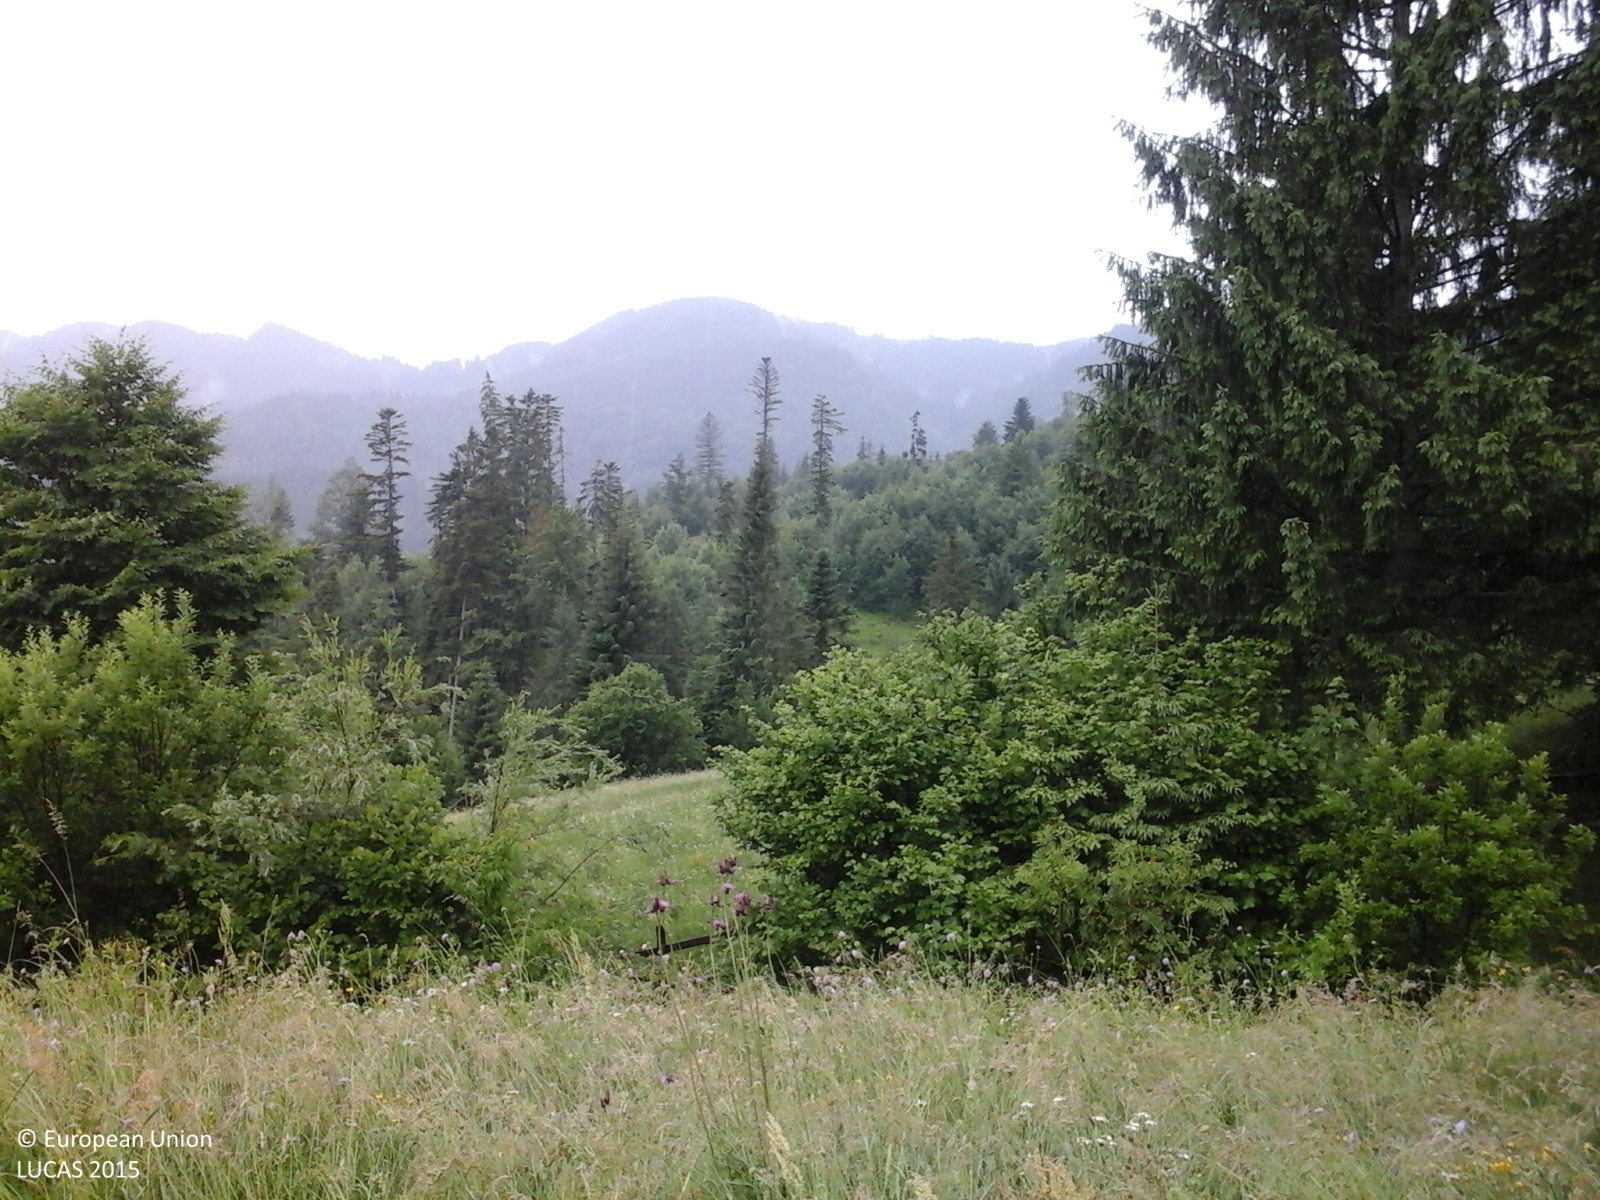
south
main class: Grassland
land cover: Grassland without tree/shrub cover
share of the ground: > 75 %
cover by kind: herbaceous plants 100 %
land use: Agriculture (excluding fallow land and kitchen gardens)
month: June
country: RO
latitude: 47.4991
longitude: 25.5290
